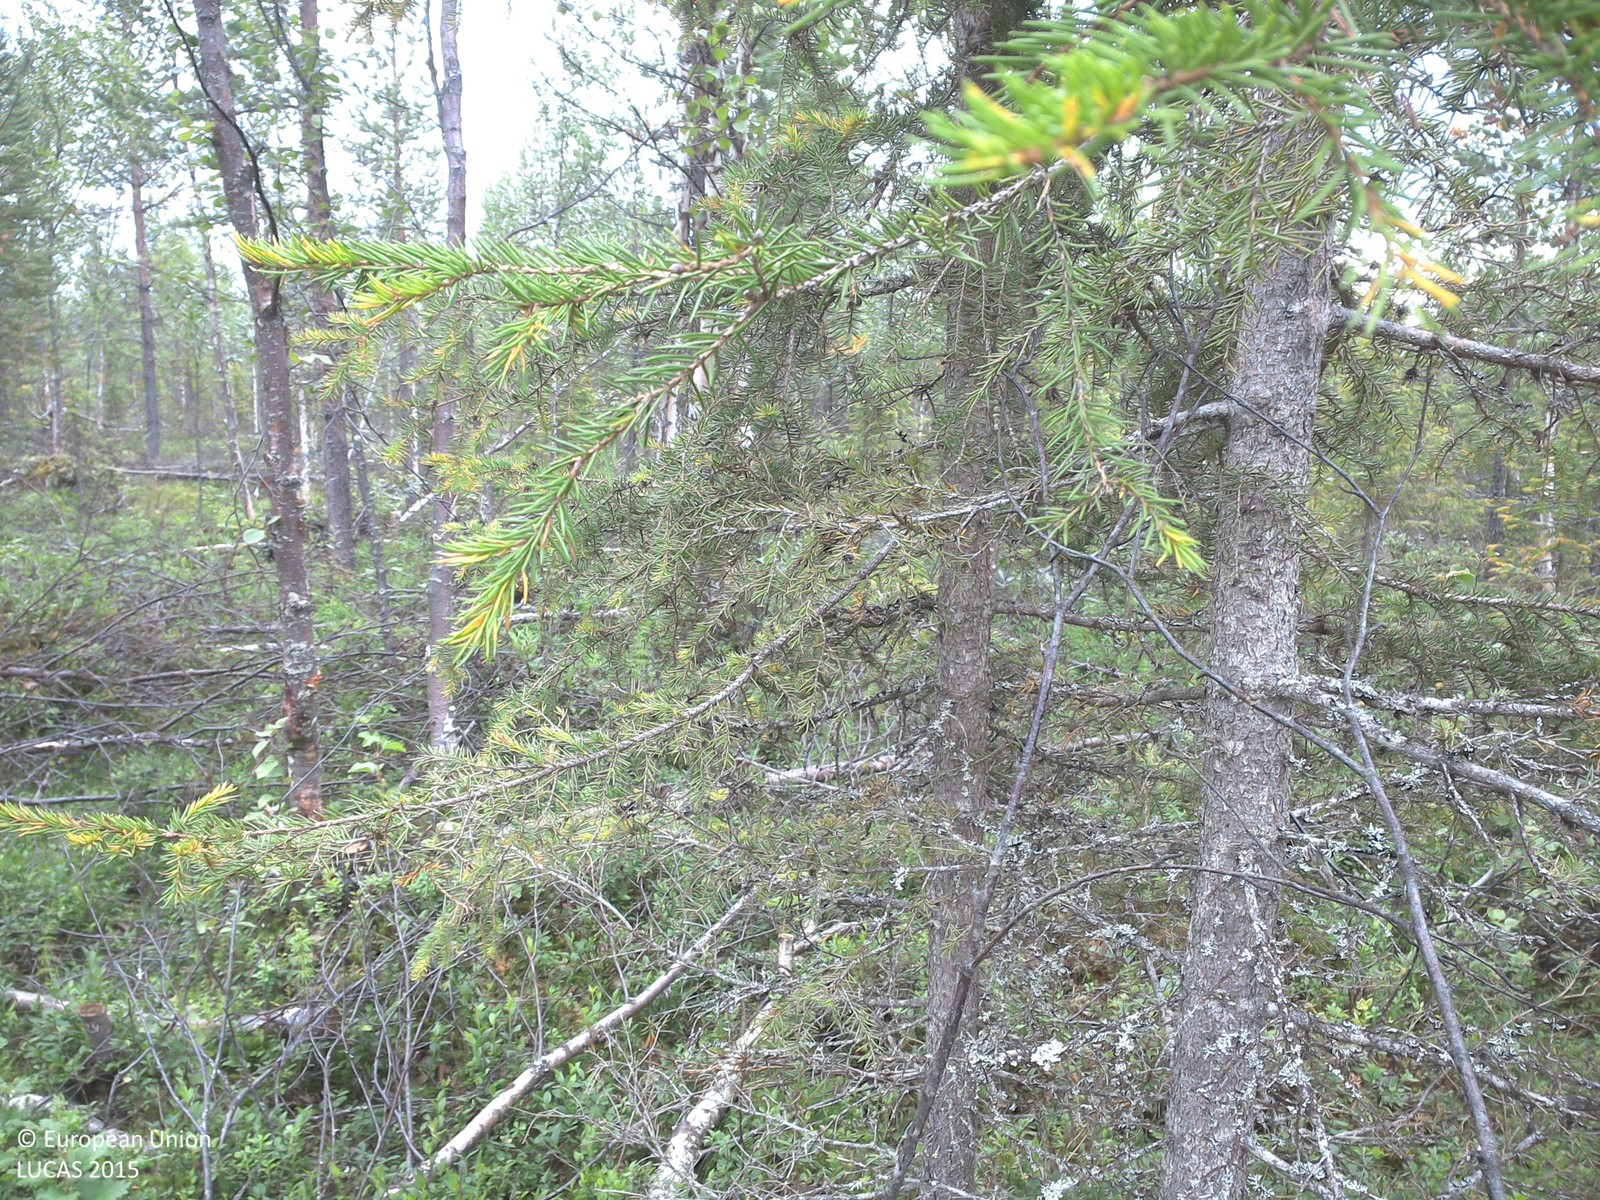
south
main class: Woodland
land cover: Pine dominated mixed woodland
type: boreal forest
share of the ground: 10 - 25 %
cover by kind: shrubs 80 %, coniferous forest trees 15 %, broadleaved forest trees 5 %
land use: Forestry
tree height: > 5 m
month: August
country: SE
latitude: 67.4487
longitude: 21.9403
